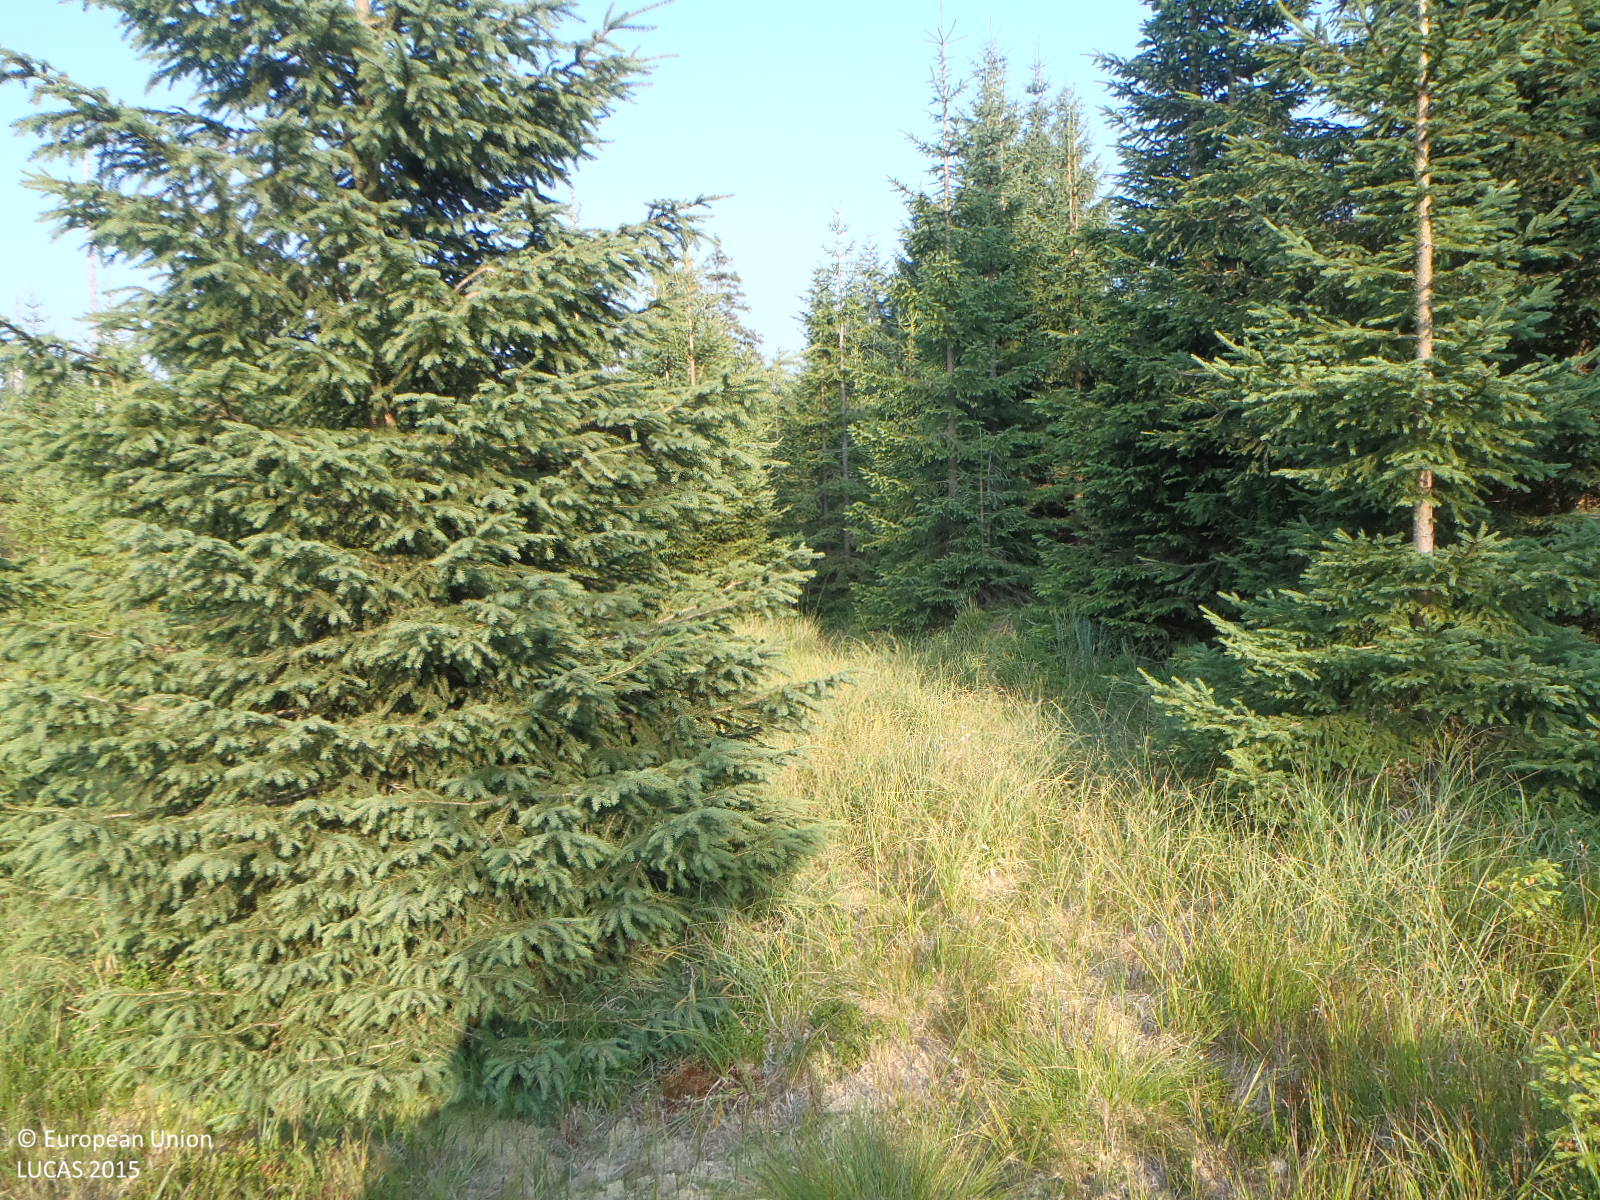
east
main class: Woodland
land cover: Spruce dominated coniferous woodland
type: mire and swamp forests
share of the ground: 25 - 50 %
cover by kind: coniferous forest trees 40 %, herbaceous plants 30 %, lichens and mosses 20 %, shrubs 10 %
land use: Semi-natural and natural areas not in use
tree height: > 5 m
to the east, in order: Spruce dominated coniferous woodland; Rivers and streams; Spruce dominated coniferous woodland; Other coniferous woodland; Spruce dominated coniferous woodland; Other coniferous woodland
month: August
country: CZ
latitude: 50.8525
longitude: 15.3305
